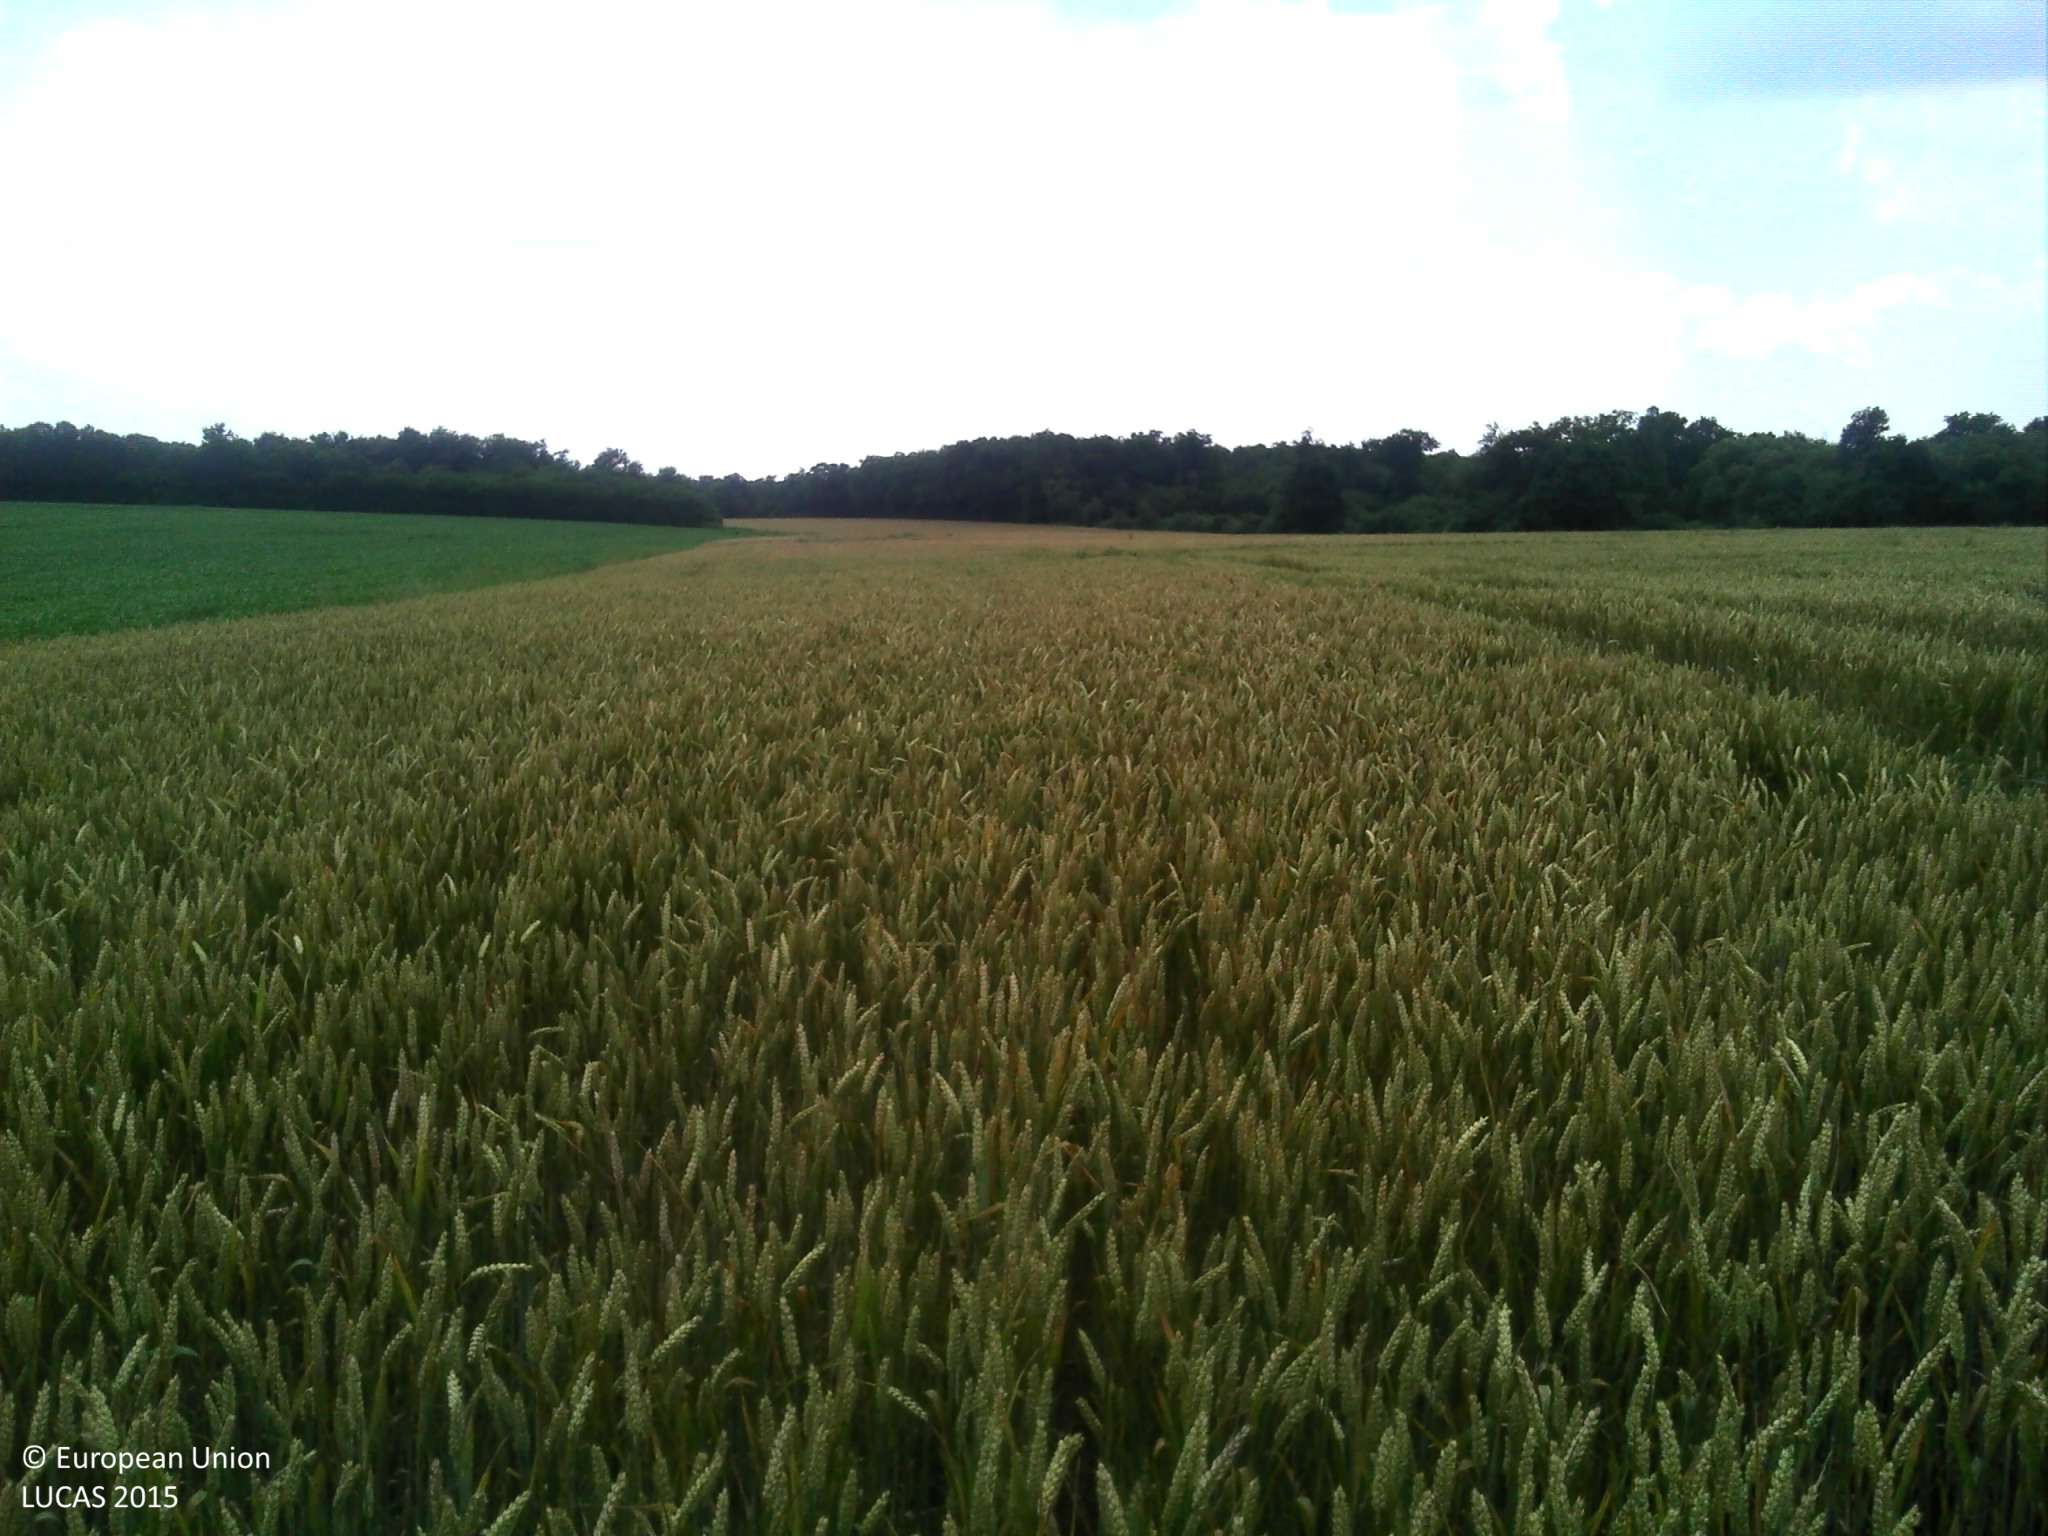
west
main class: Cropland
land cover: Common wheat
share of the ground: > 75 %
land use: Agriculture (excluding fallow land and kitchen gardens)
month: June
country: FR
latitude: 45.9051
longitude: -0.6859
